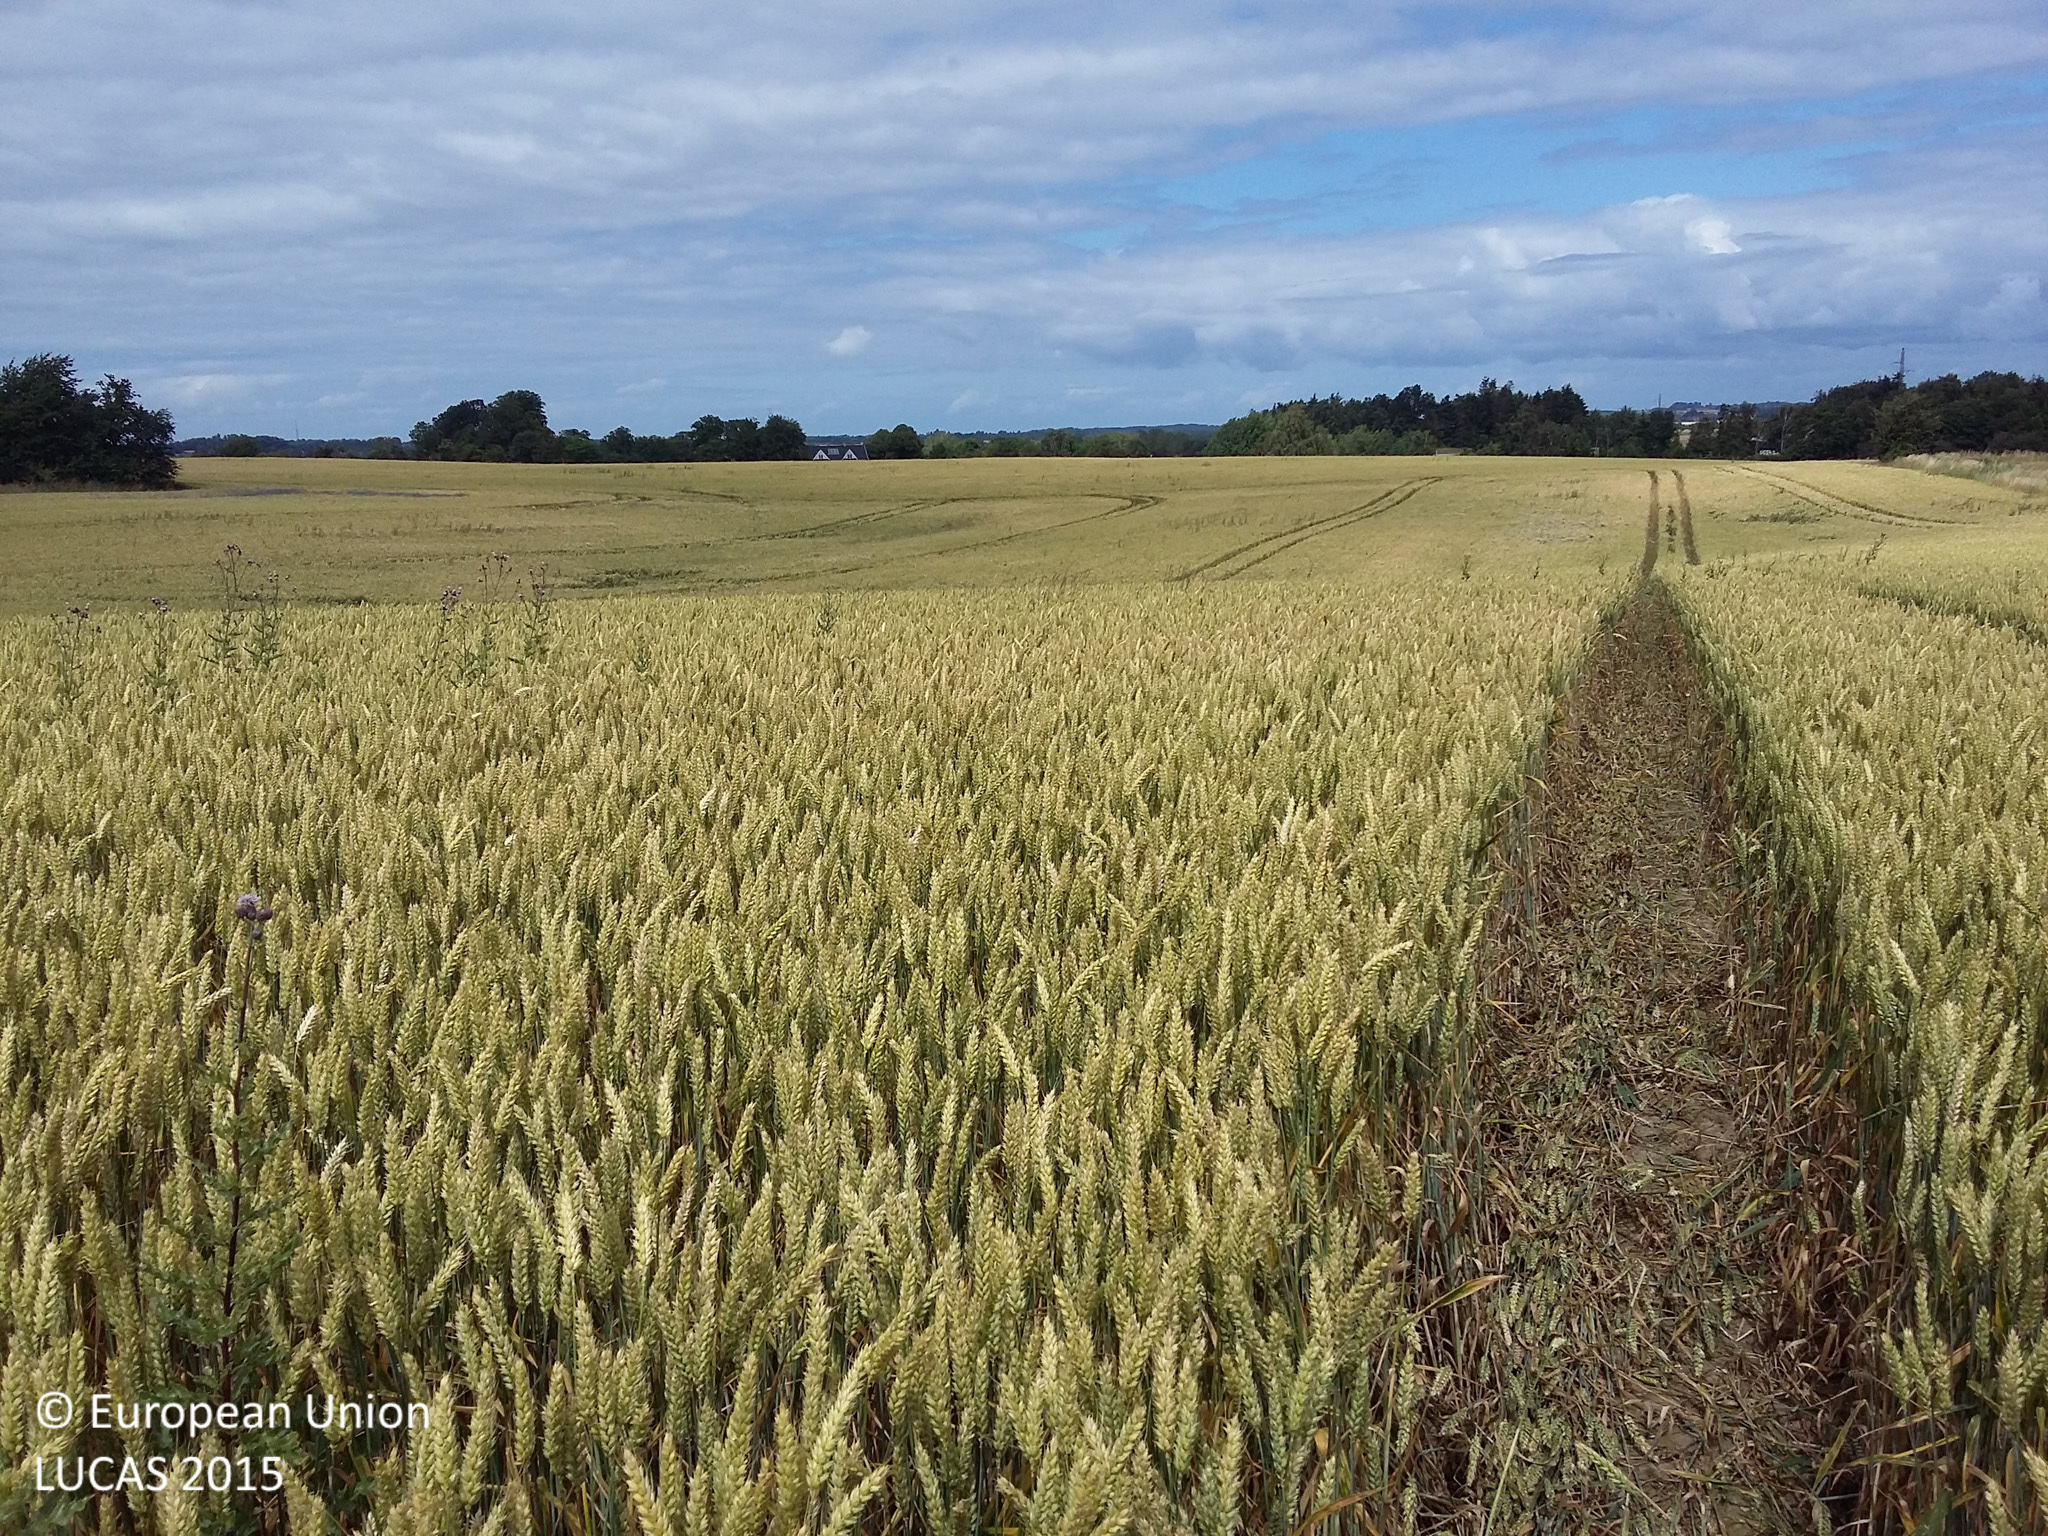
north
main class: Cropland
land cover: Common wheat
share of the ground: > 75 %
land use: Agriculture (excluding fallow land and kitchen gardens)
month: July
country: DK
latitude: 56.0257
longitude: 12.1640
